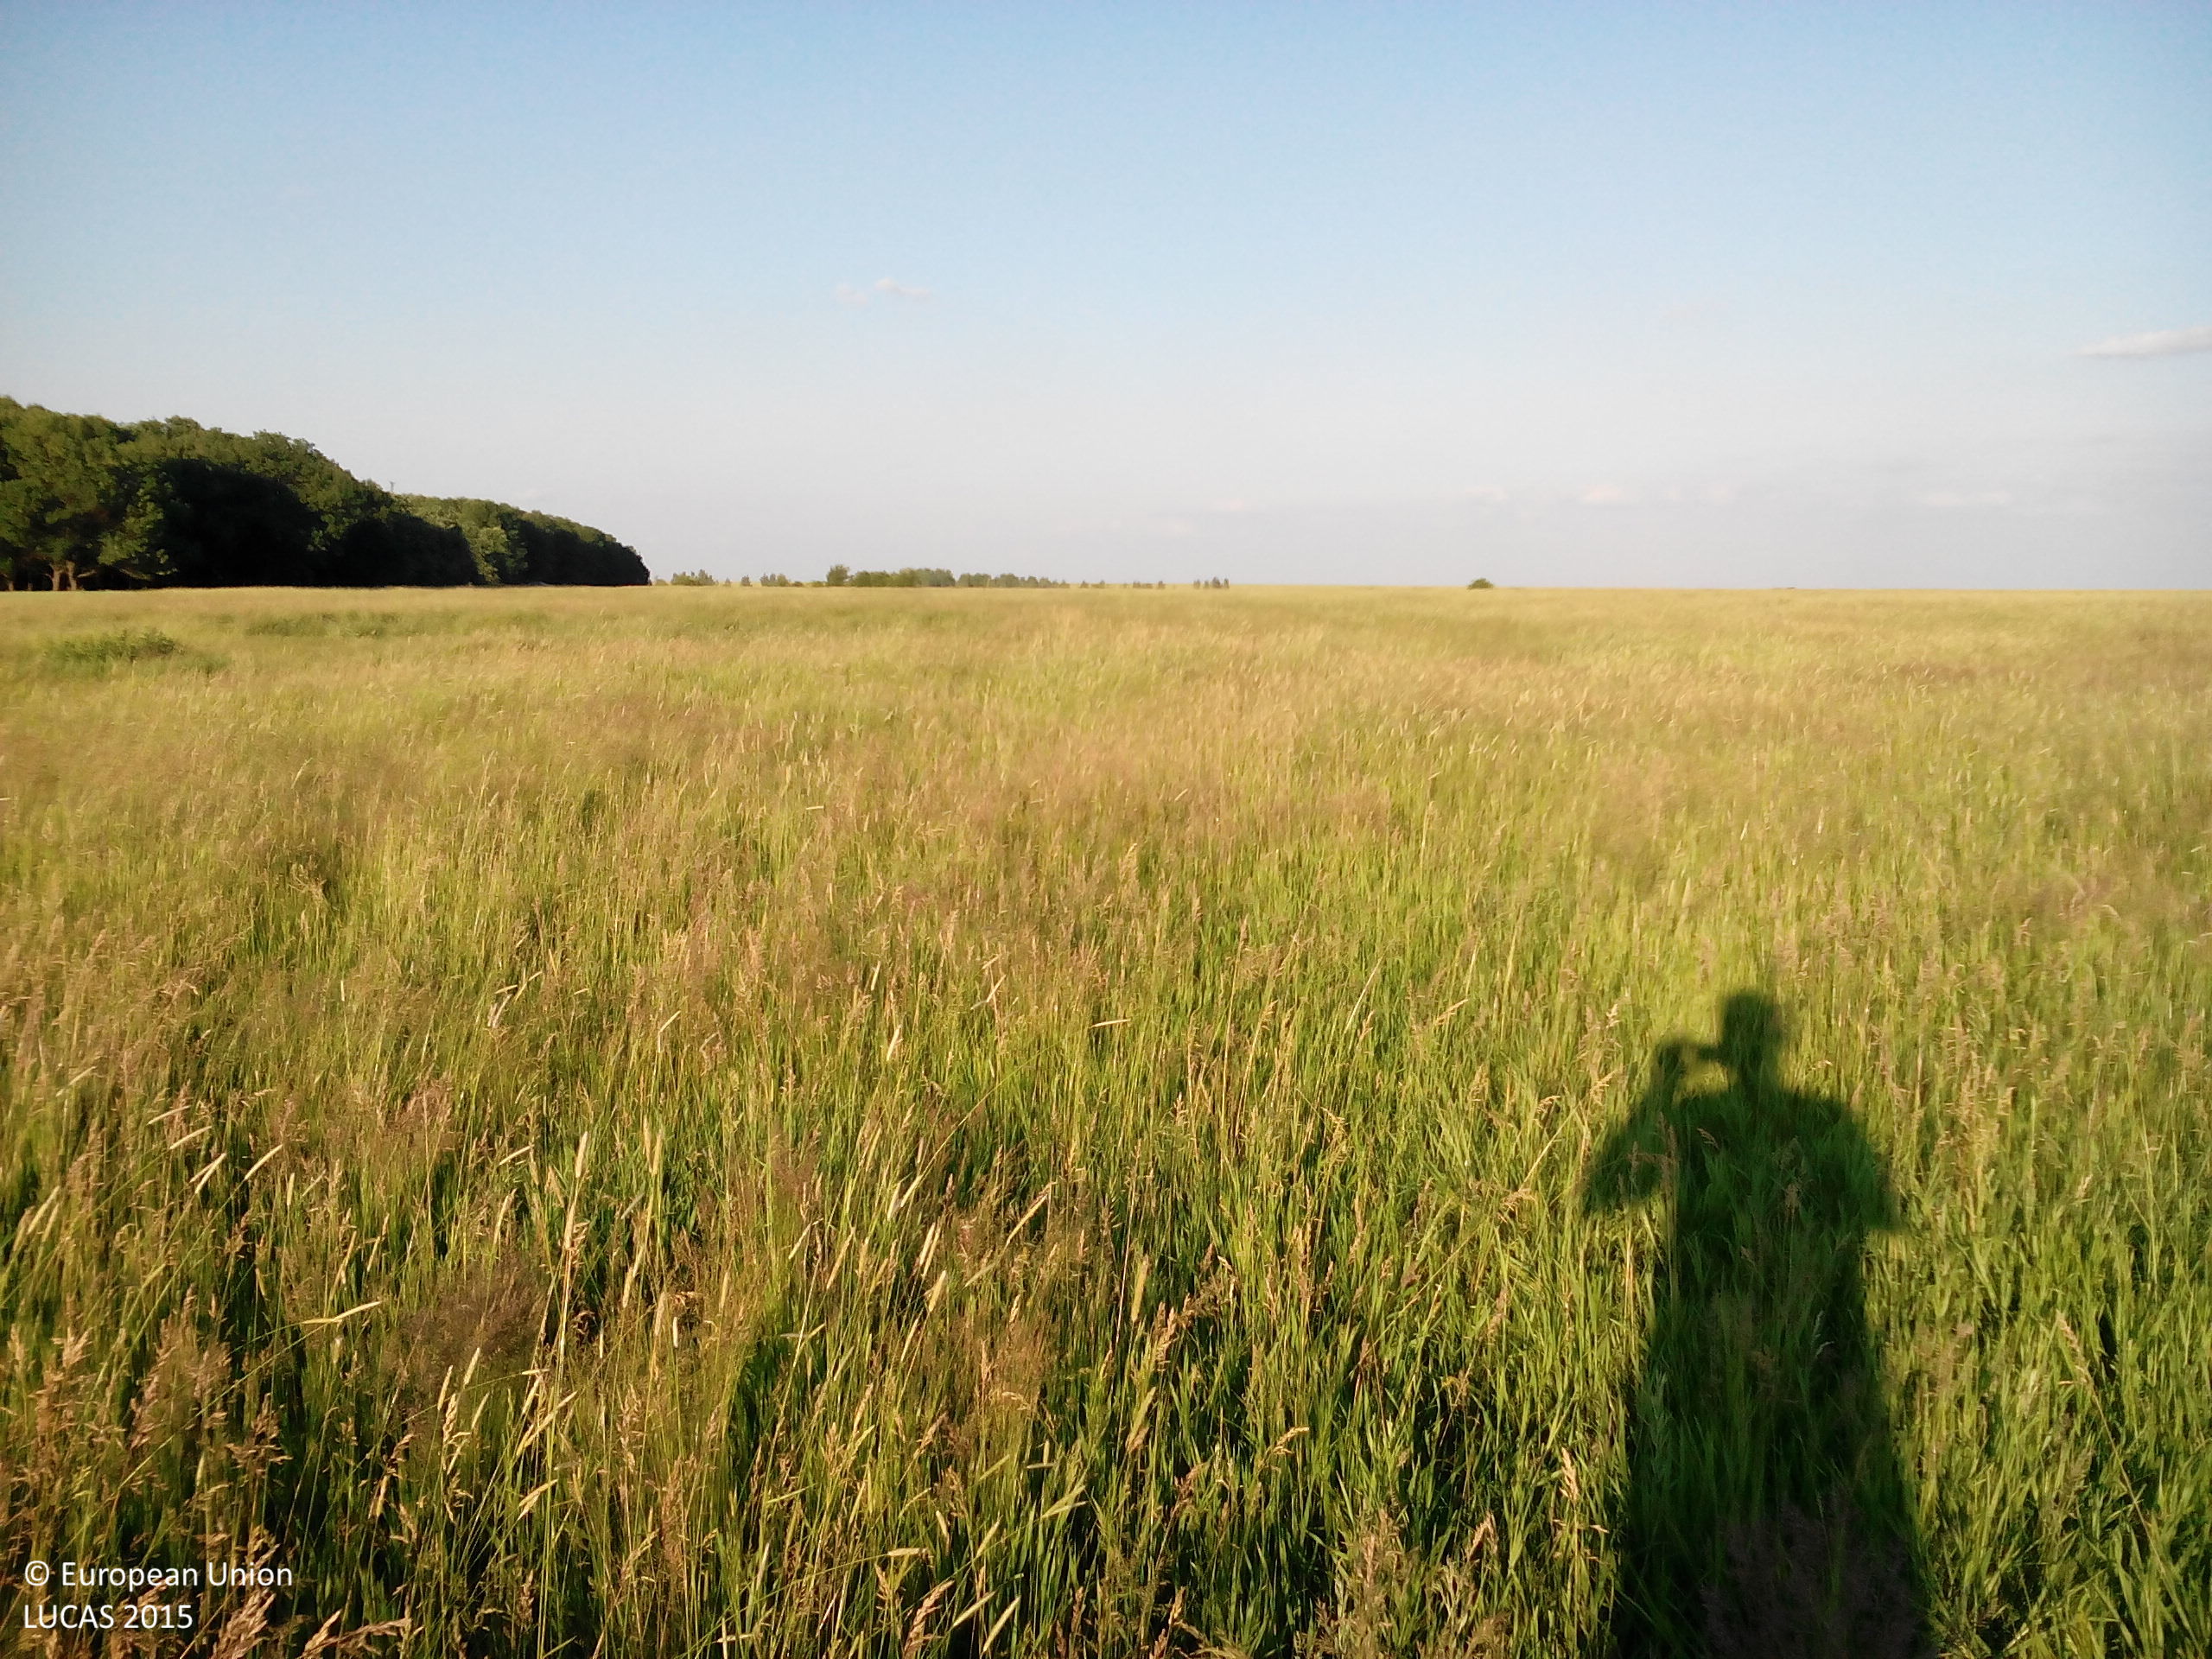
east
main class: Grassland
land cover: Grassland without tree/shrub cover
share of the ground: > 75 %
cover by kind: herbaceous plants 100 %
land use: Agriculture (excluding fallow land and kitchen gardens)
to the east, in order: Grassland without tree/shrub cover; Tracks; Grassland without tree/shrub cover
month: May
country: BG
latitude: 43.4272
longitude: 23.7721
